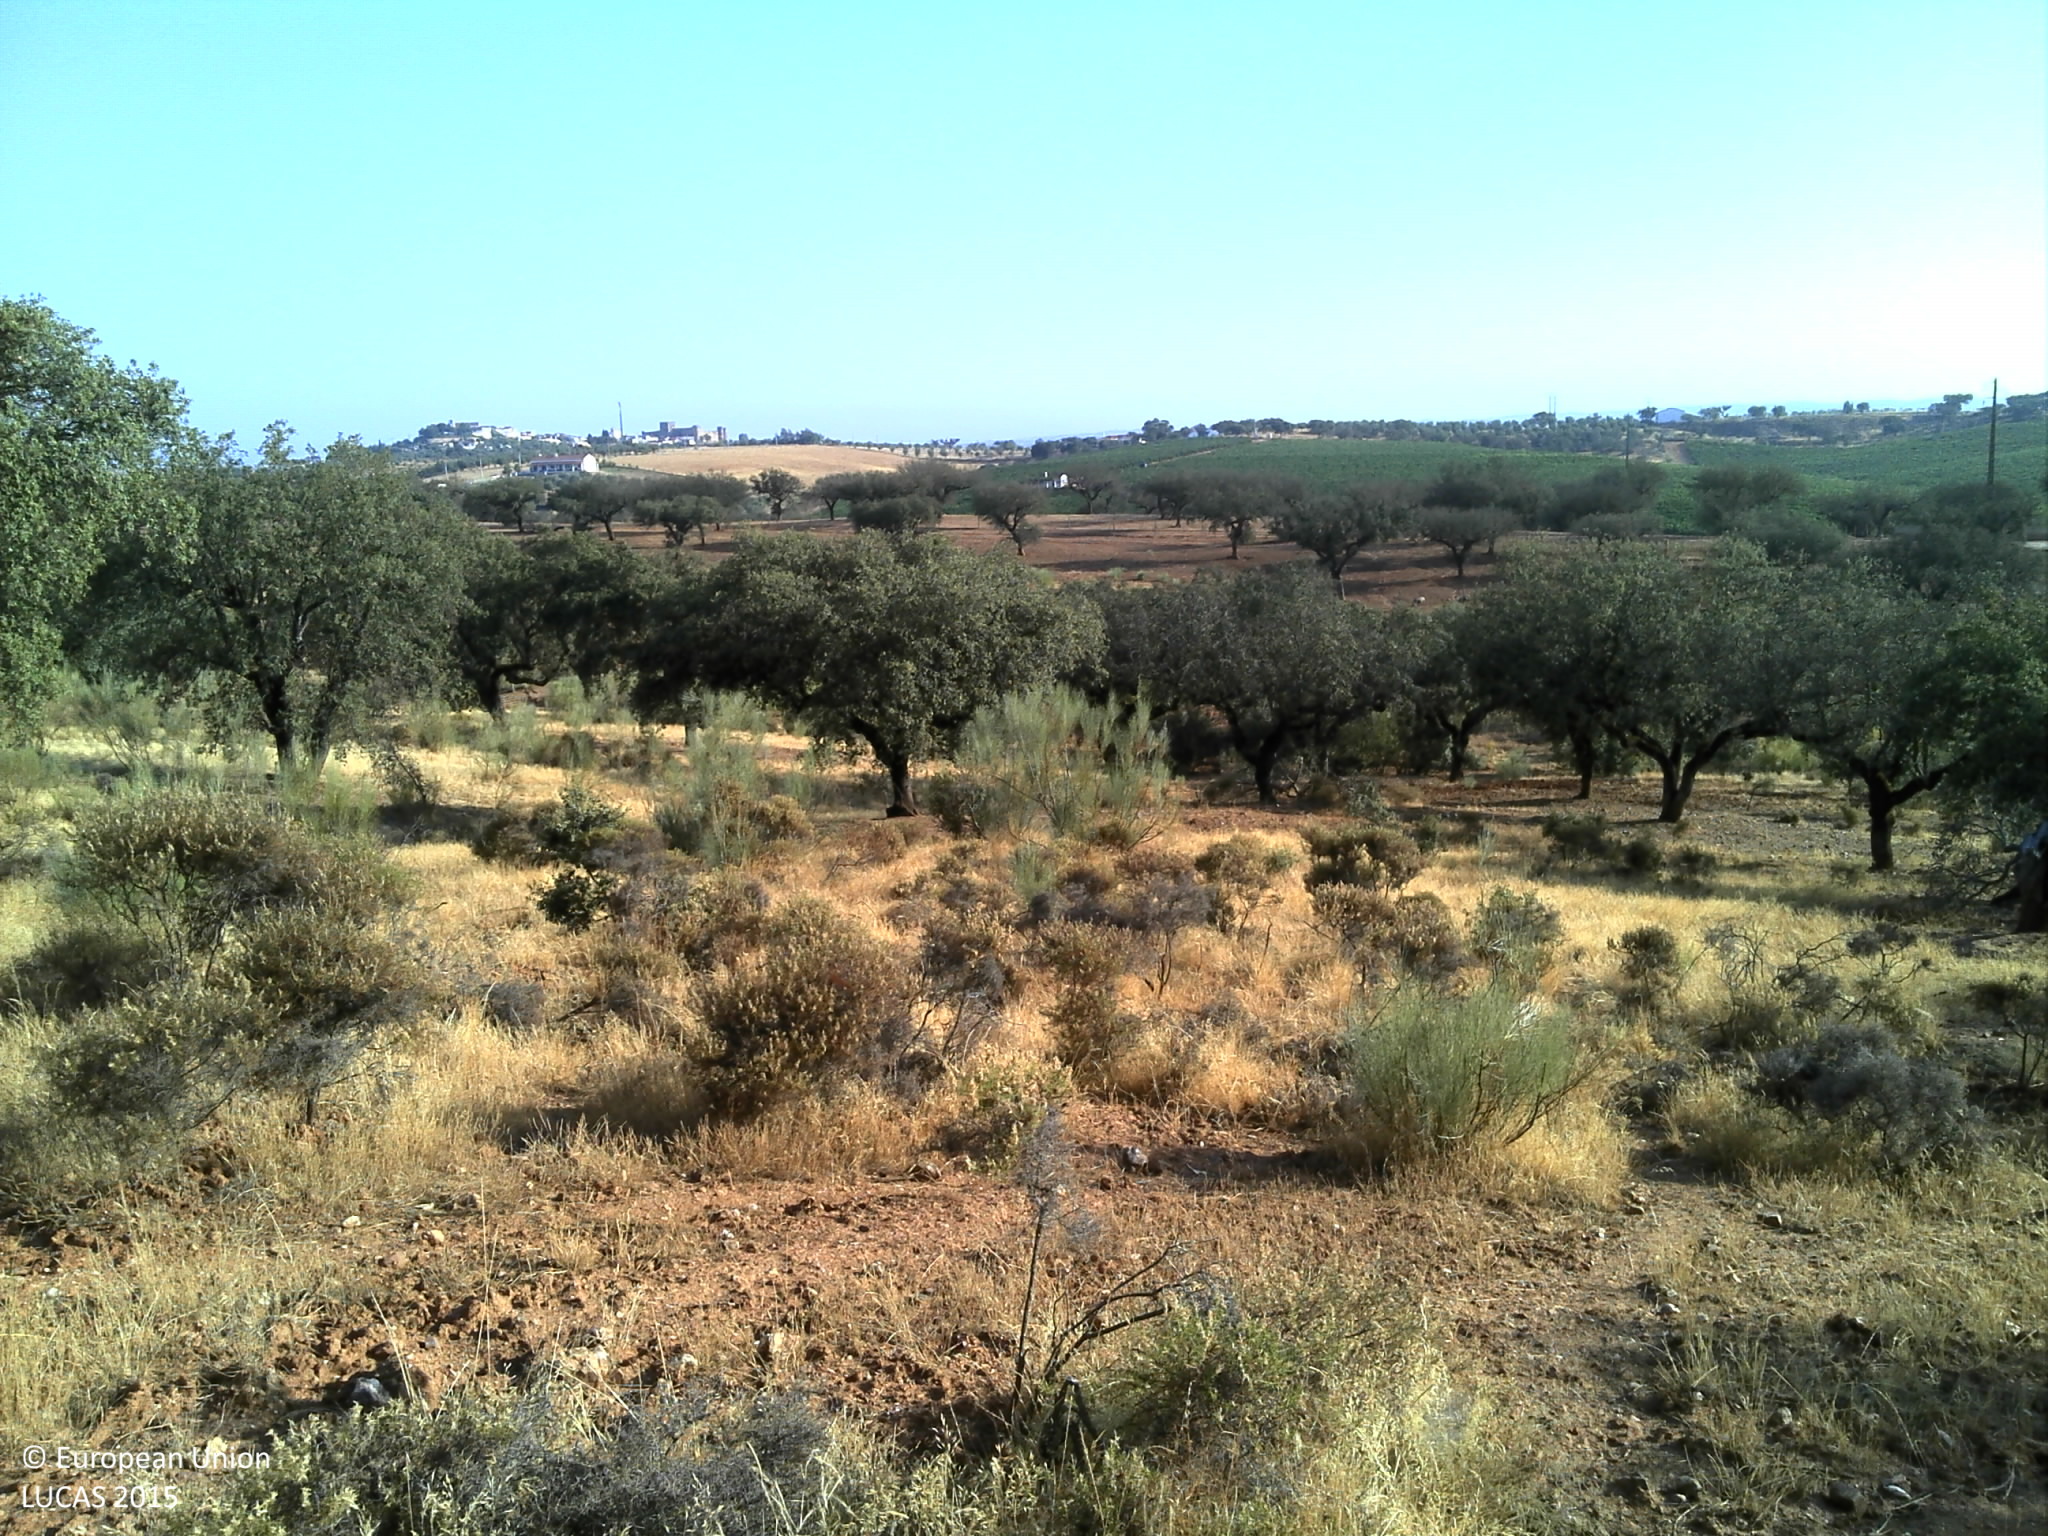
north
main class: Woodland
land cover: Broadleaved woodland
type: broadleaved evergreen forest
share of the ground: 10 - 25 %
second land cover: Shrubland without tree cover
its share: 25 - 50 %
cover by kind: shrubs 30 %, herbaceous plants 30 %, broadleaved forest trees 25 %, unconsolidated bare surface 15 %
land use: Forestry
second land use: Agriculture (excluding fallow land and kitchen gardens)
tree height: > 5 m
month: July
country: PT
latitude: 38.6062
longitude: -7.4025
